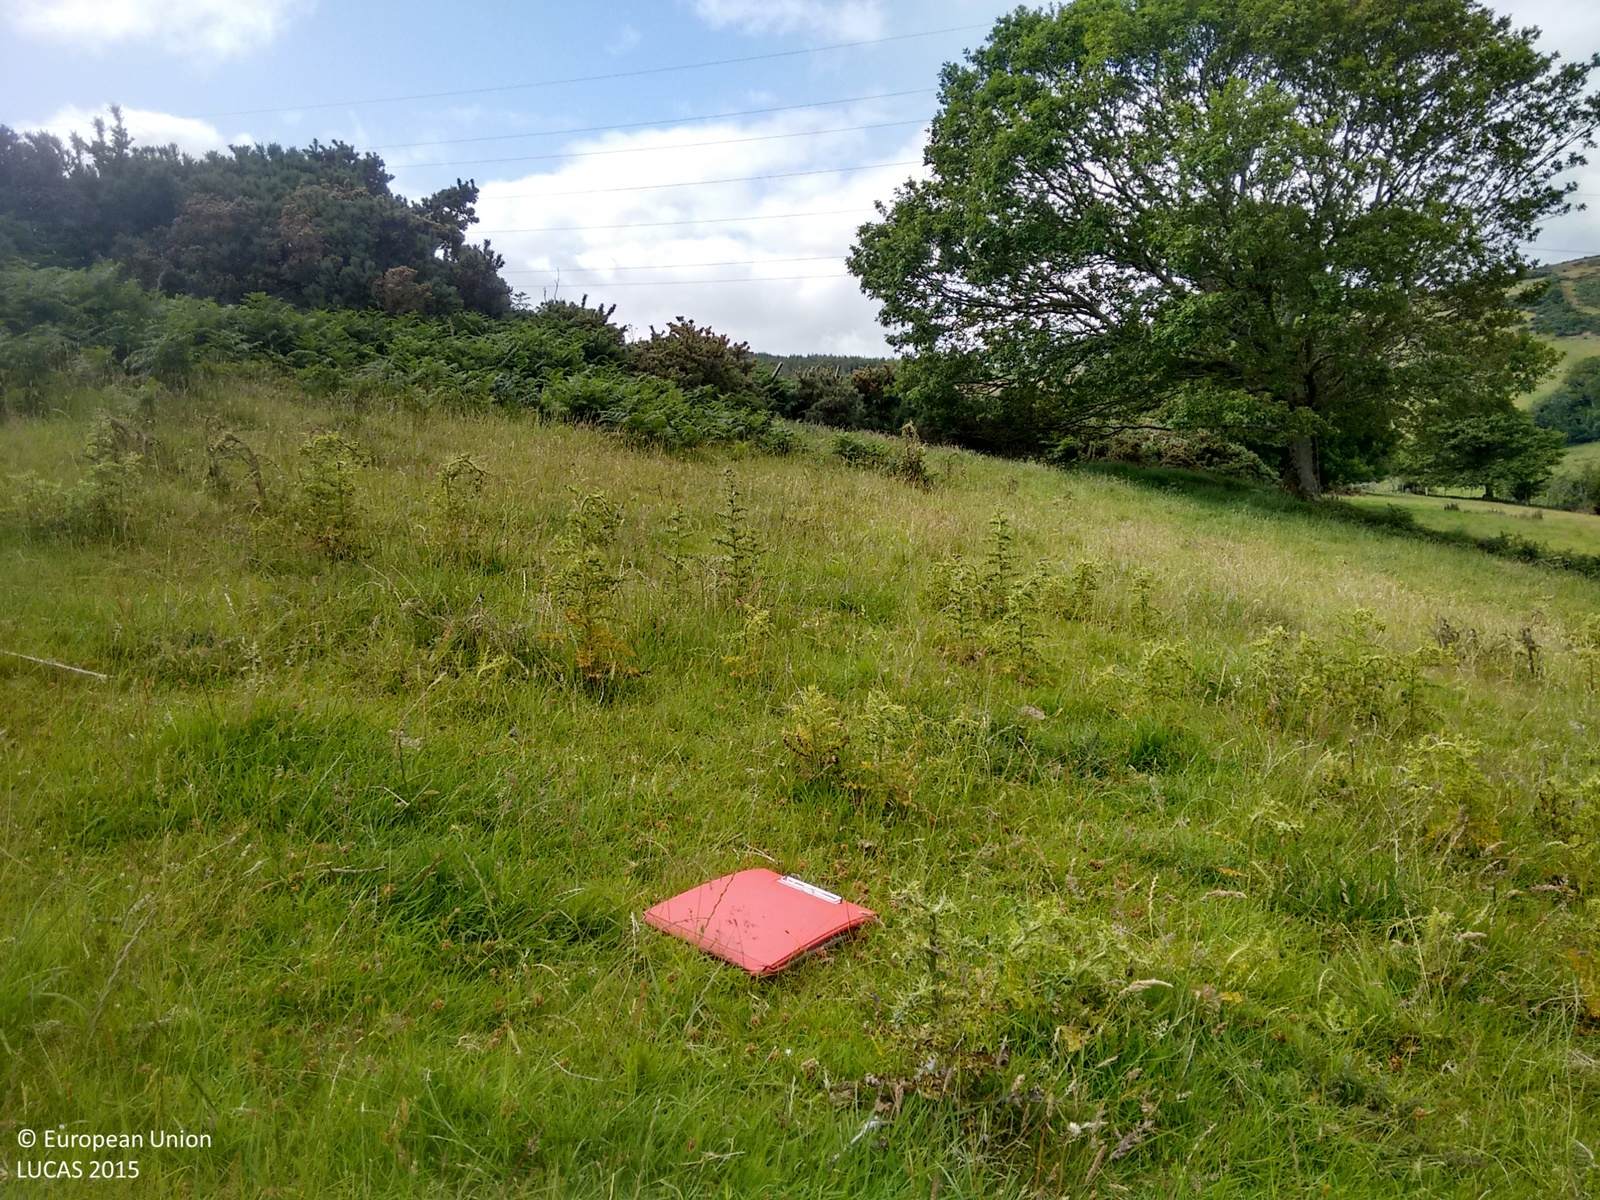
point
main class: Grassland
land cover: Grassland without tree/shrub cover
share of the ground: > 75 %
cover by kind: herbaceous plants 100 %
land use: Agriculture (excluding fallow land and kitchen gardens)
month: July
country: IE
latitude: 53.1369
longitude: -6.1256
